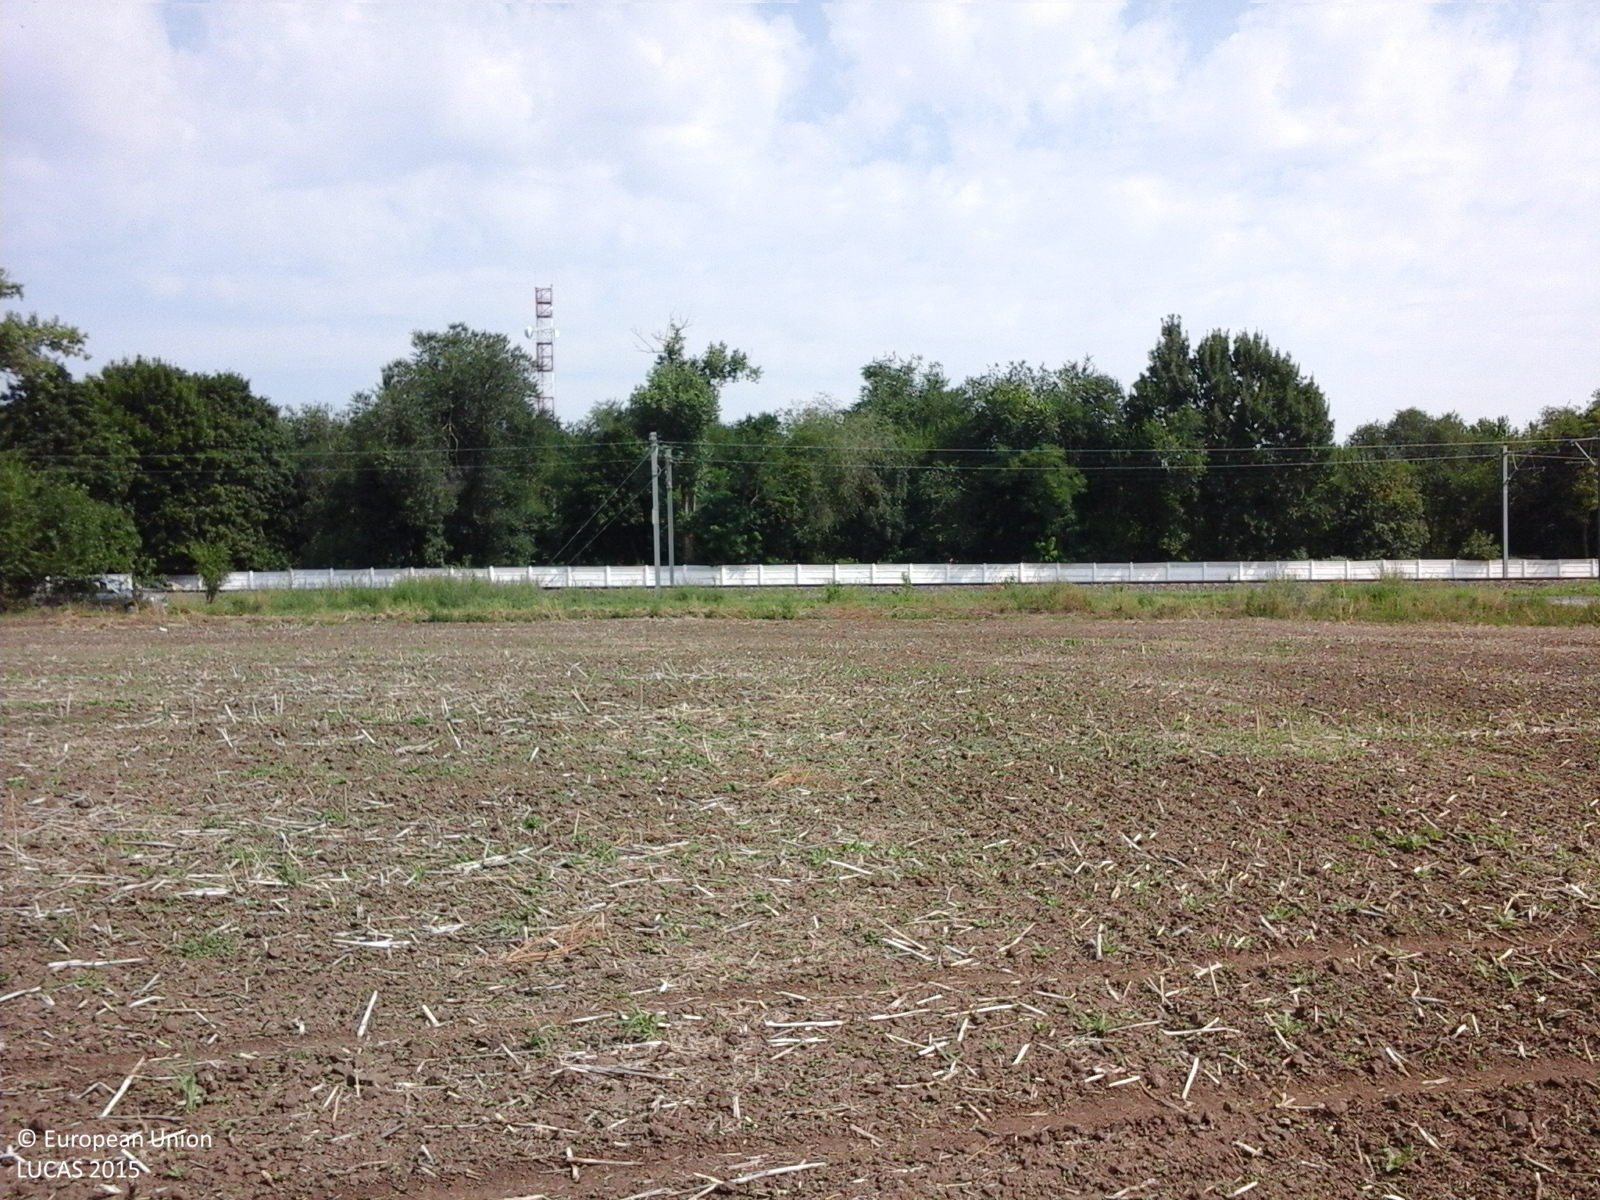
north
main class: Cropland
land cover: Rape and turnip rape
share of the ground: < 10 %
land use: Agriculture (excluding fallow land and kitchen gardens)
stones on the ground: < 10 %
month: July
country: RO
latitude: 44.4223
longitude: 27.5651
